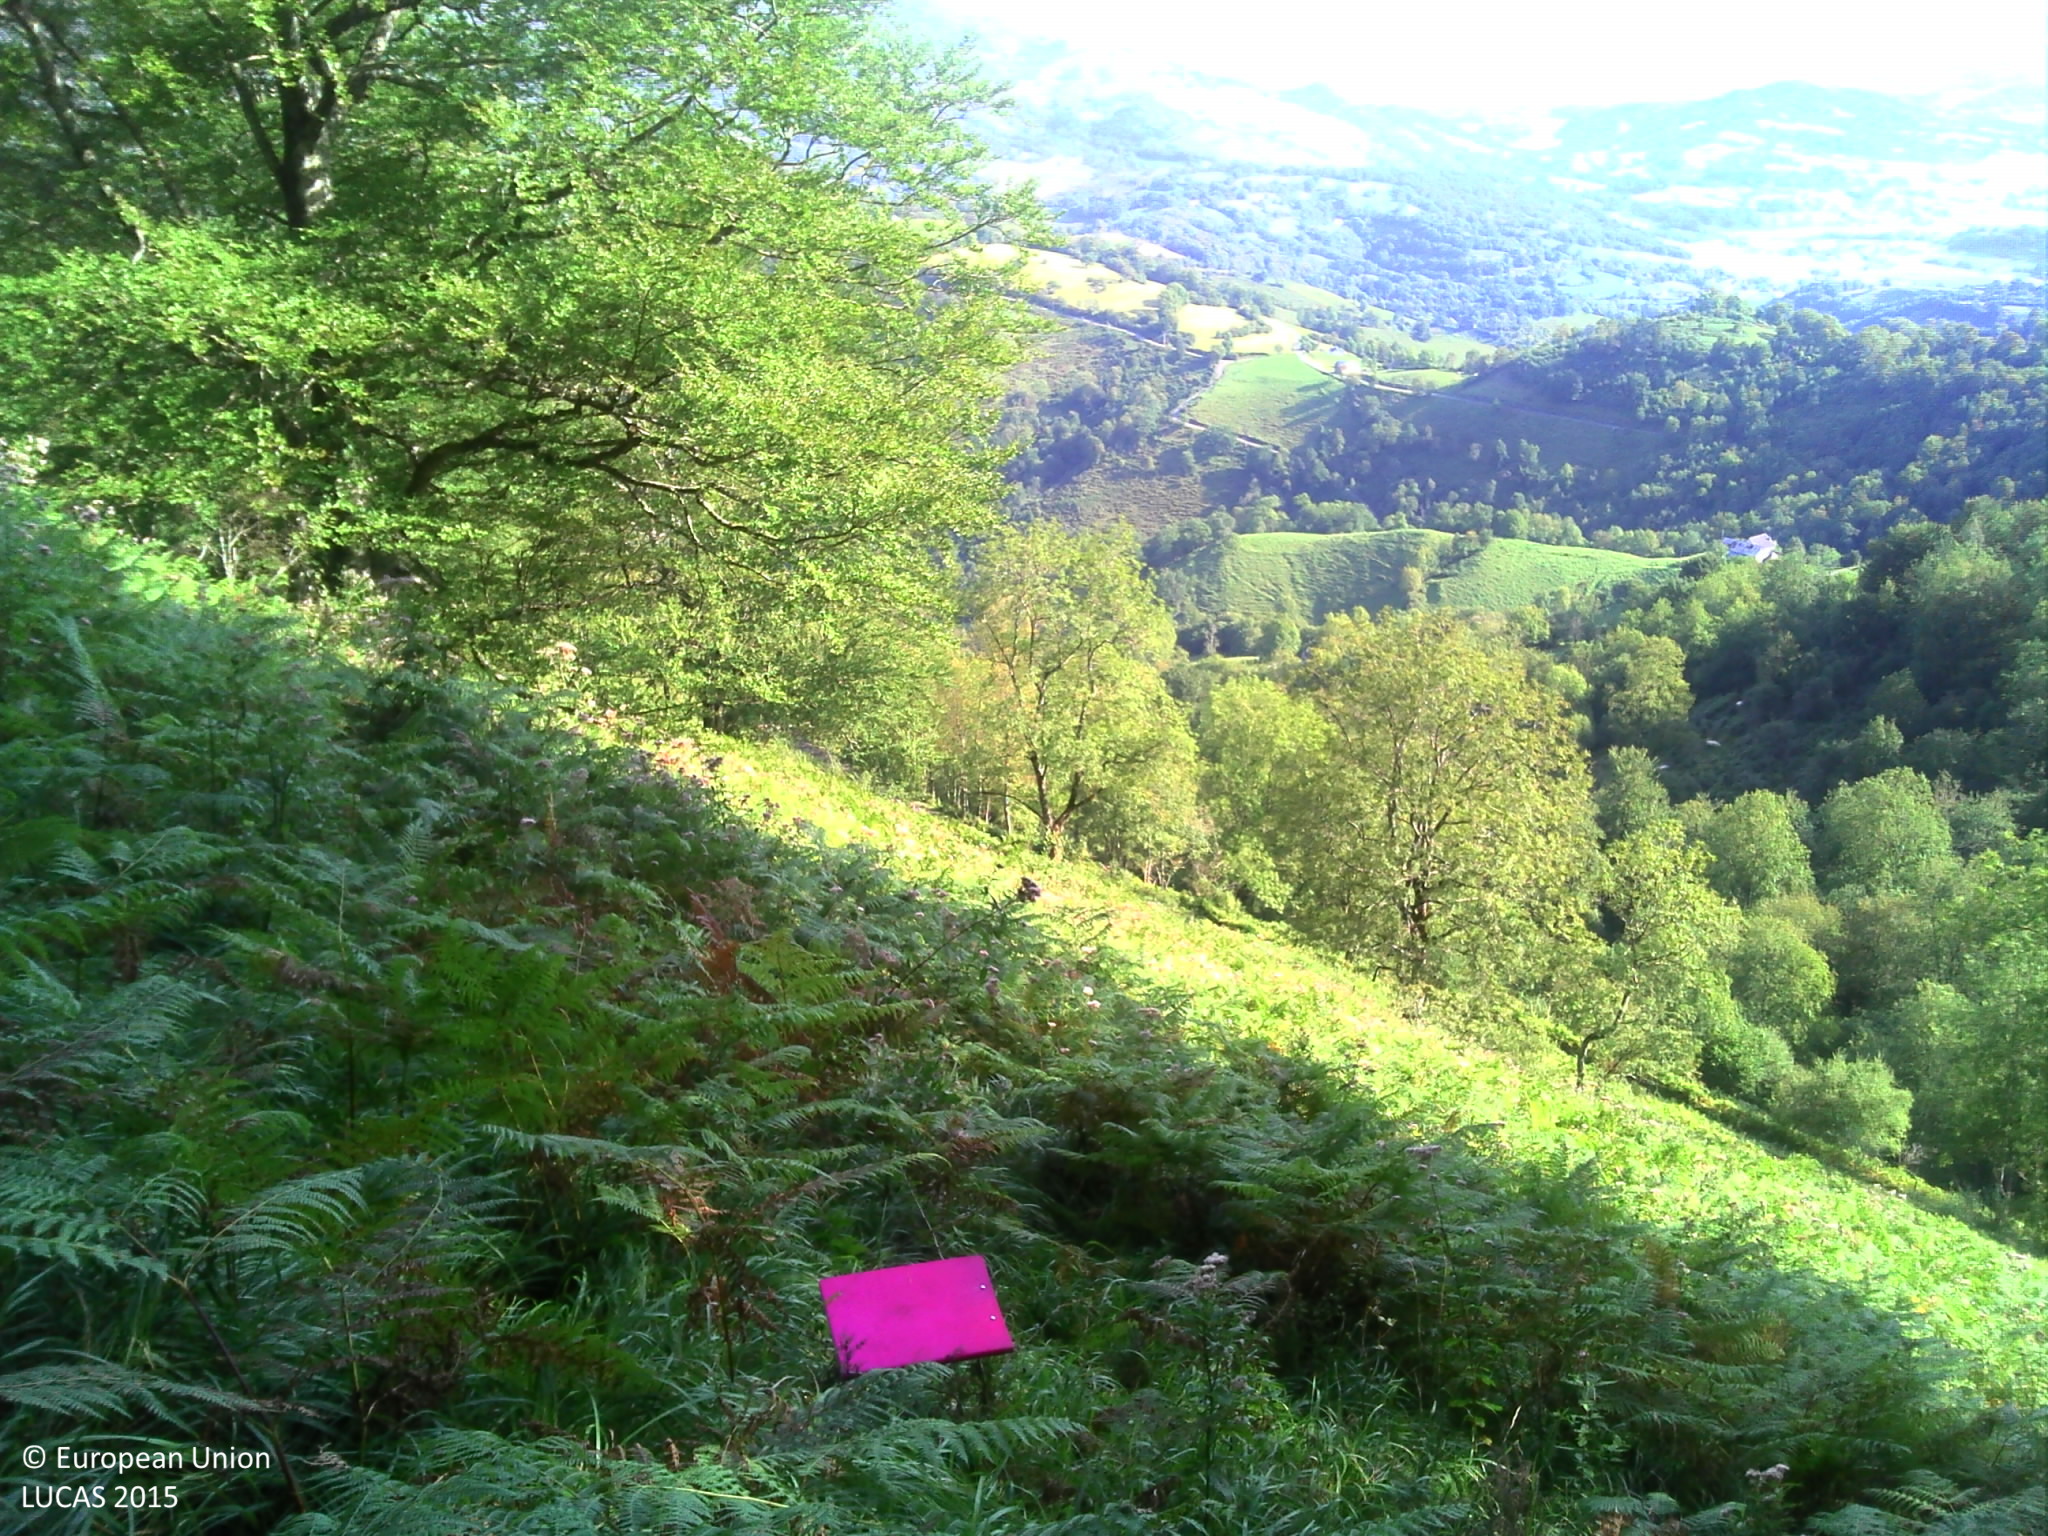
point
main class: Woodland
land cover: Broadleaved woodland
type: beech forest
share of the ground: 25 - 50 %
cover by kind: herbaceous plants 50 %, broadleaved forest trees 40 %, shrubs 10 %
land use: Forestry
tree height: > 5 m
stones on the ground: 10 - 25 %
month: September
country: FR
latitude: 43.0597
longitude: -0.9502
